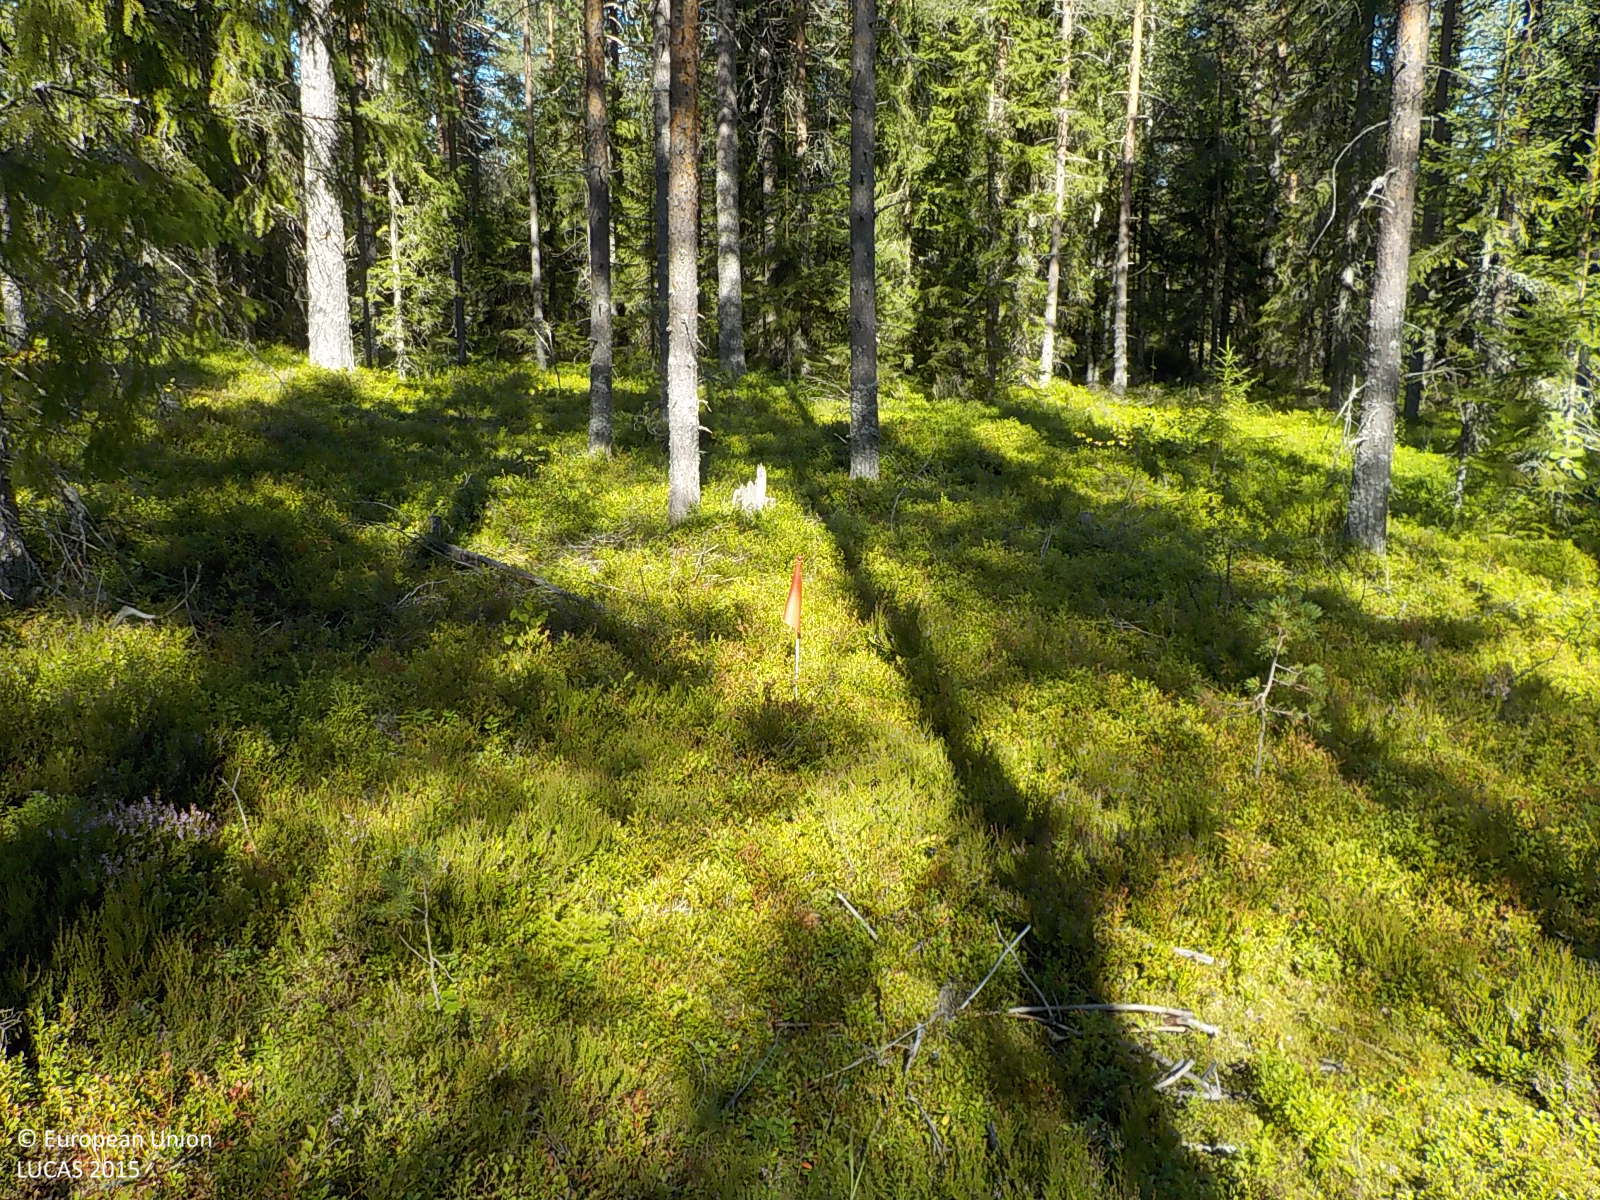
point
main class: Woodland
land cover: Pine dominated coniferous woodland
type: boreal forest
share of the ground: 50 - 75 %
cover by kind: coniferous forest trees 70 %, shrubs 30 %
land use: Forestry
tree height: > 5 m
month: August
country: SE
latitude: 63.1687
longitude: 18.5374
